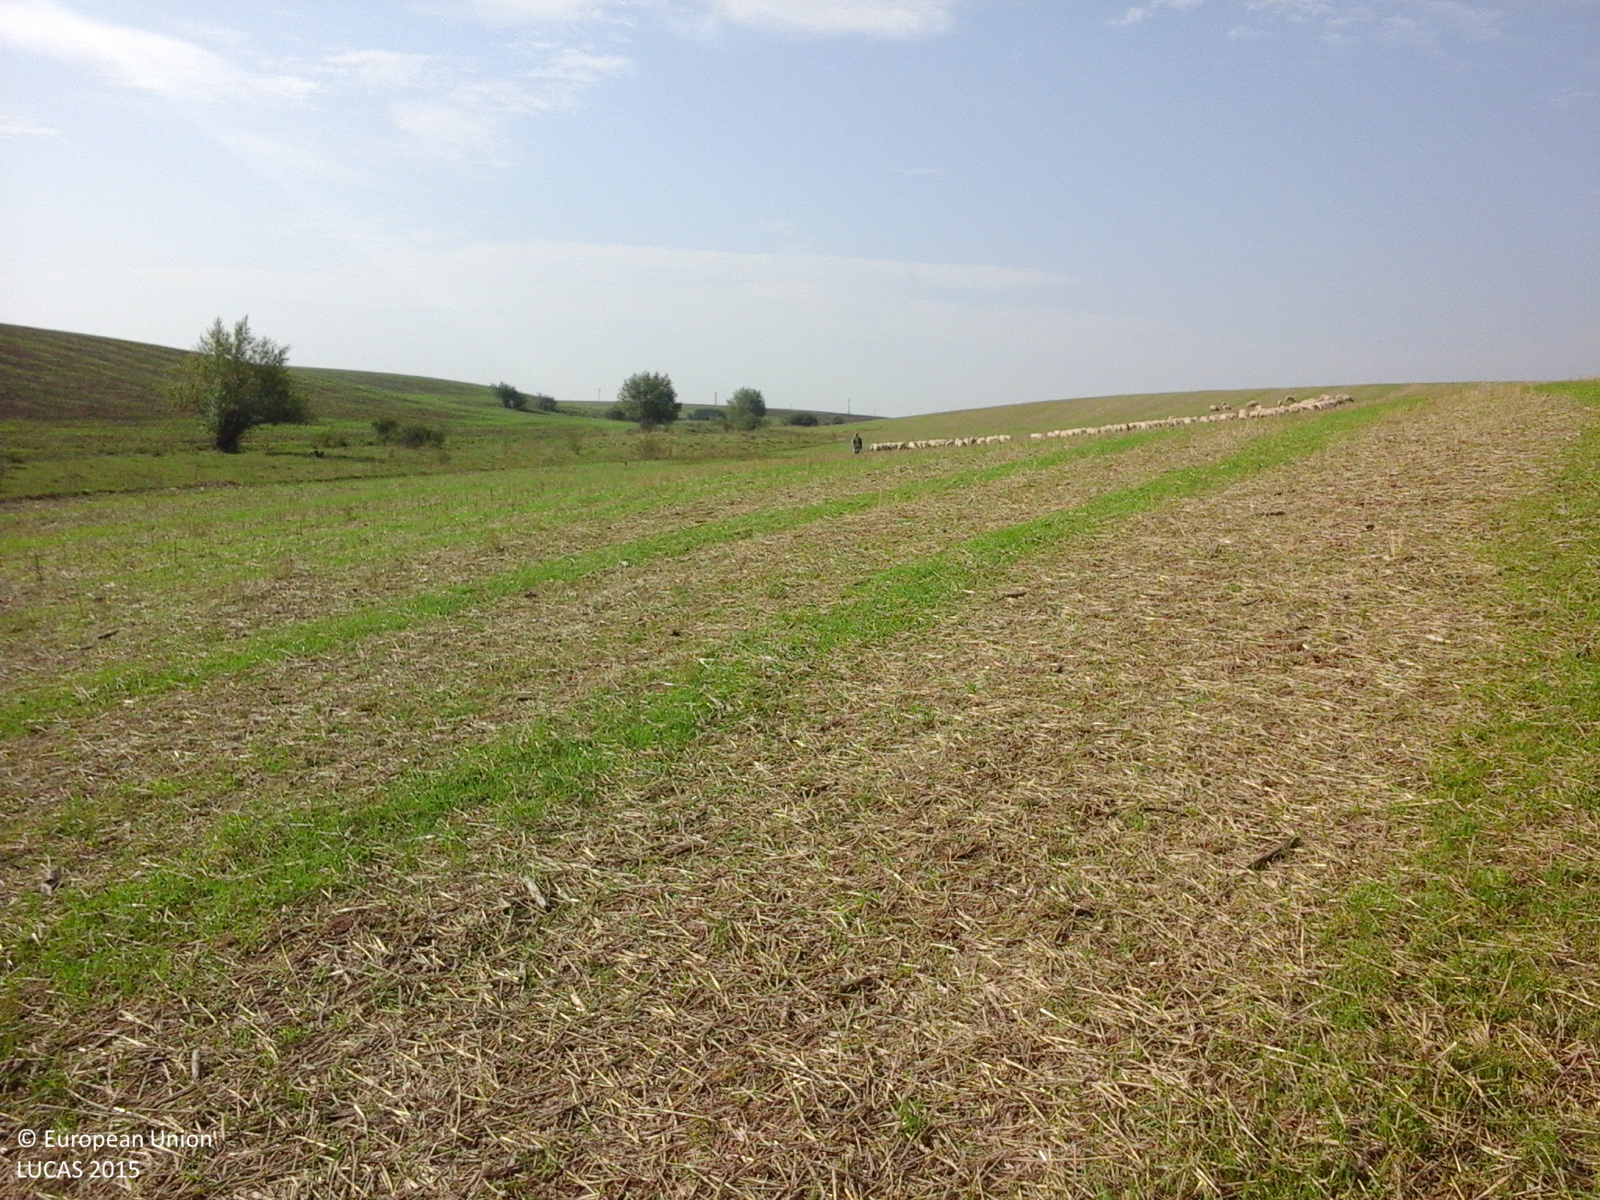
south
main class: Cropland
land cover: Common wheat
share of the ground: 50 - 75 %
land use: Agriculture (excluding fallow land and kitchen gardens)
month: August
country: RO
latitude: 46.0916
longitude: 21.5080
